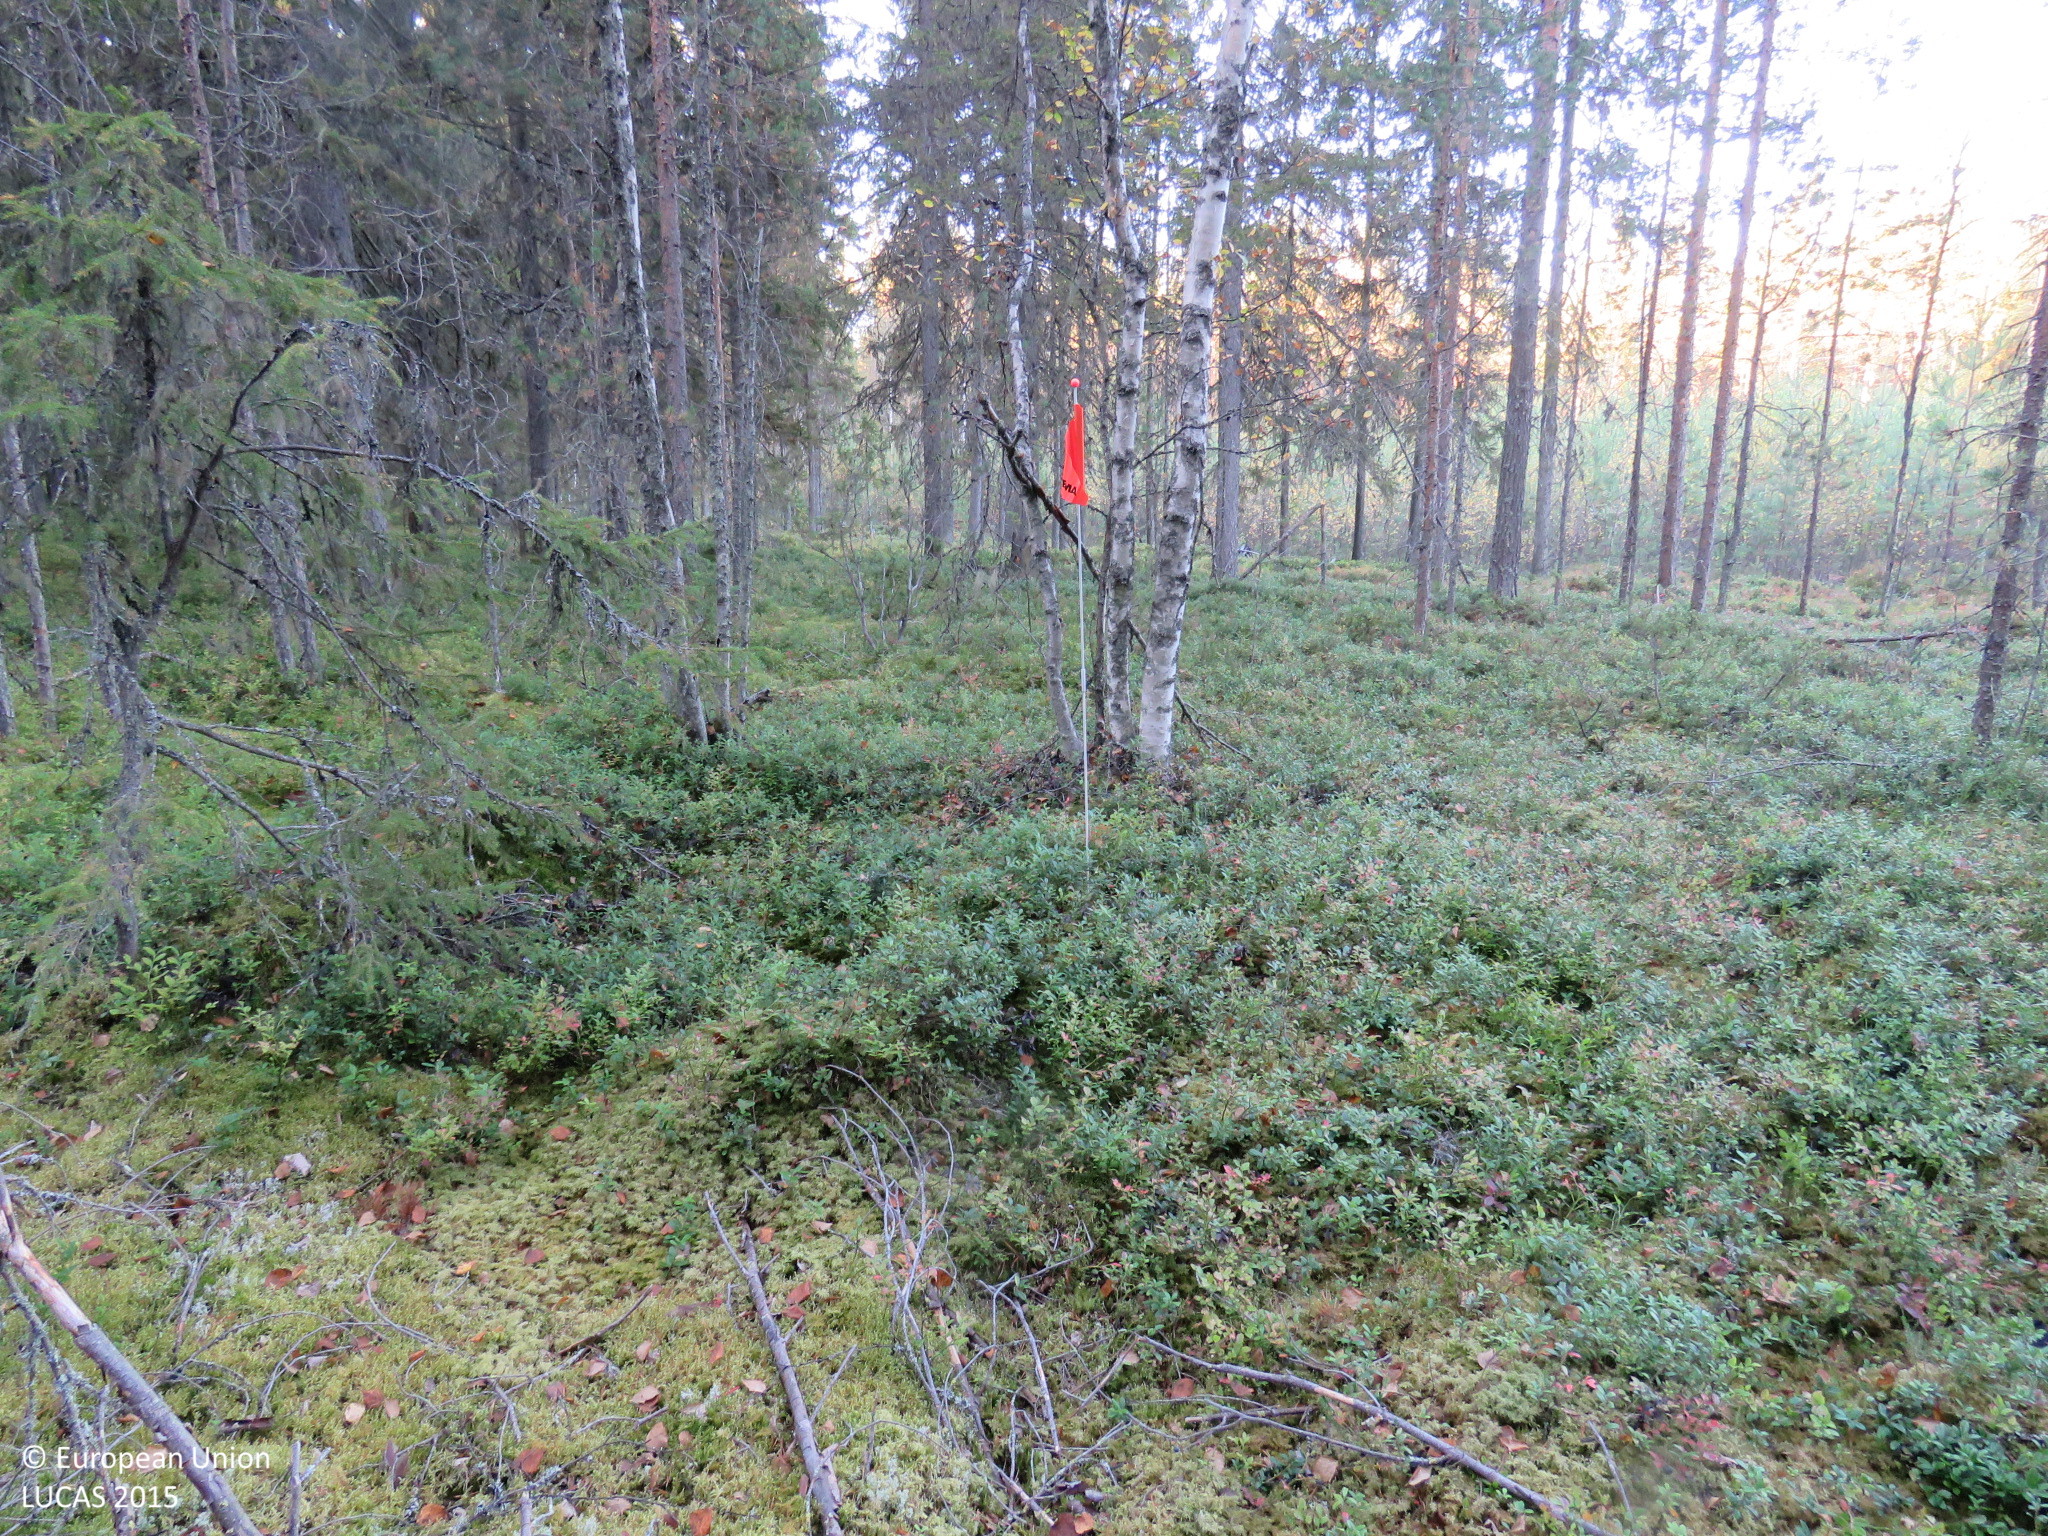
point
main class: Woodland
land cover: Other coniferous woodland
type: boreal forest
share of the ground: > 75 %
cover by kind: coniferous forest trees 70 %, shrubs 15 %, broadleaved forest trees 10 %, lichens and mosses 5 %
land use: Forestry
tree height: > 5 m
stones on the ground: < 10 %
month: September
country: FI
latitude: 65.0389
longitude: 26.3940
